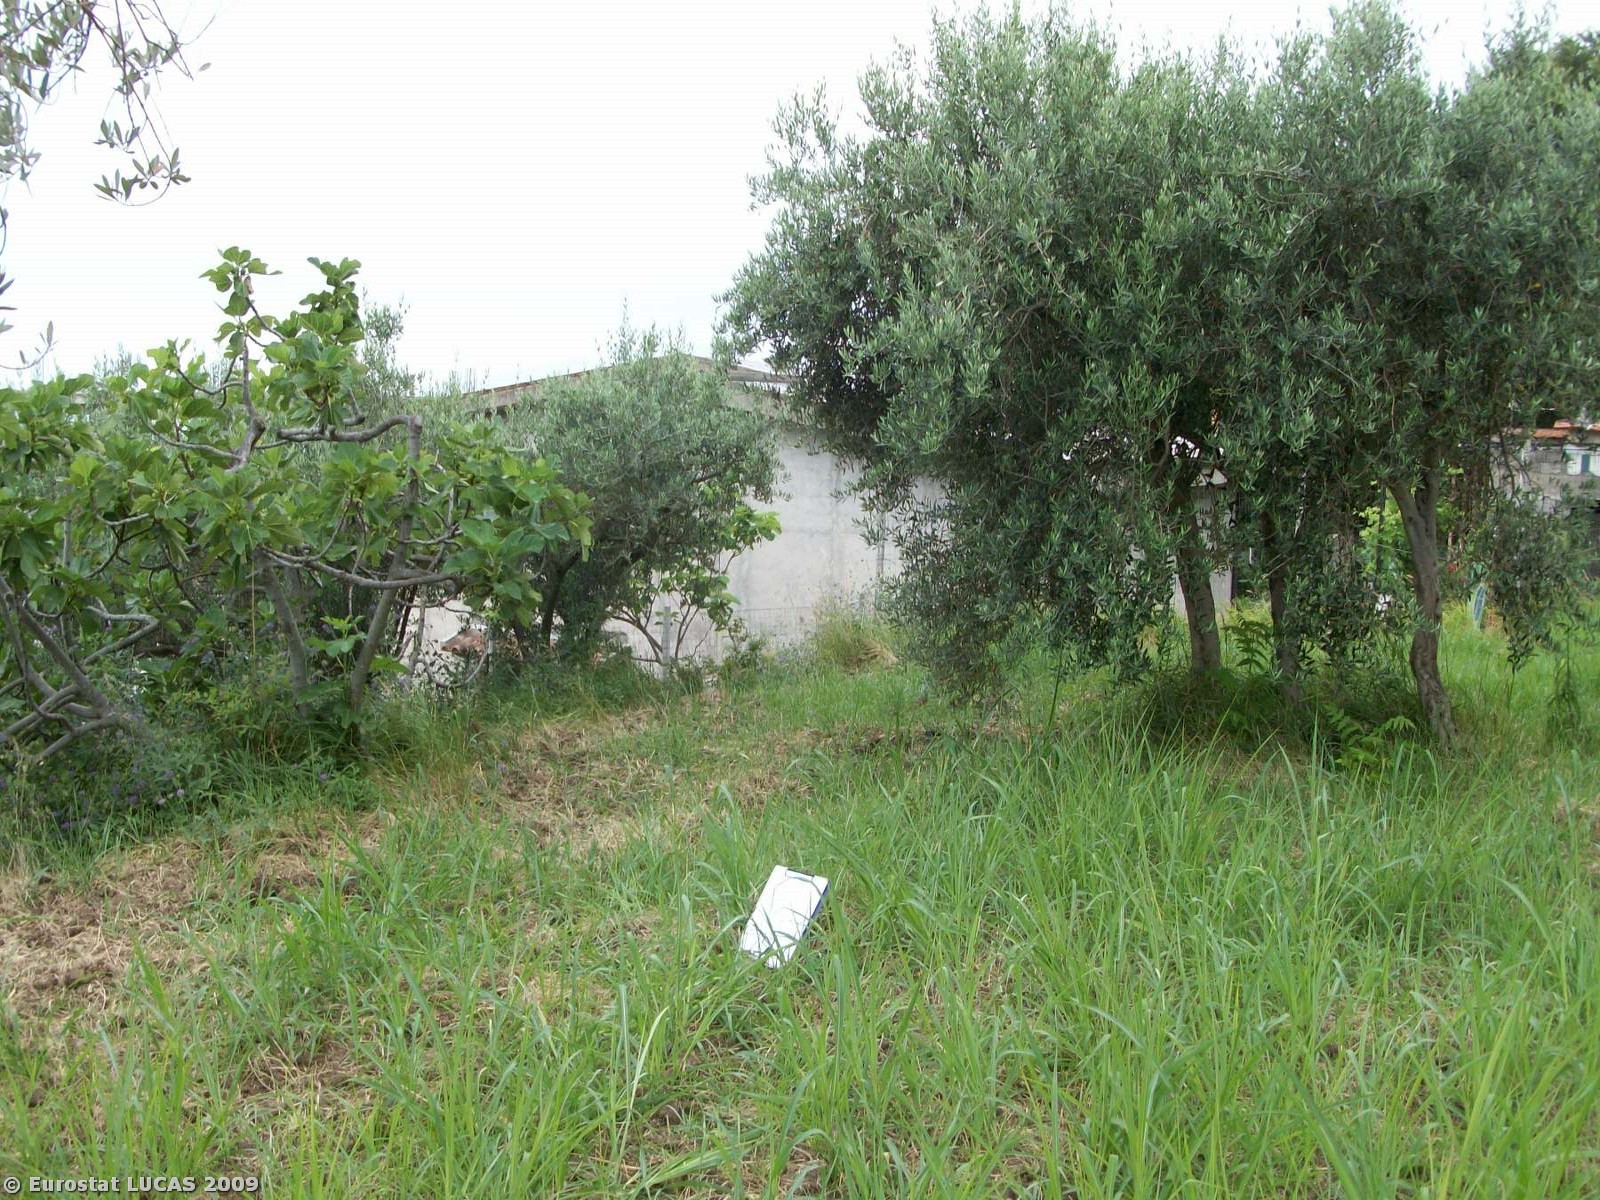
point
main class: Cropland
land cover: Olive groves
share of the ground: 10 - 25 %
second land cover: Spontaneously vegetated surfaces
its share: > 75 %
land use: Agriculture (excluding fallow land and kitchen gardens)
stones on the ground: < 10 %
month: June
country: IT
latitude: 39.3731
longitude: 16.0412
